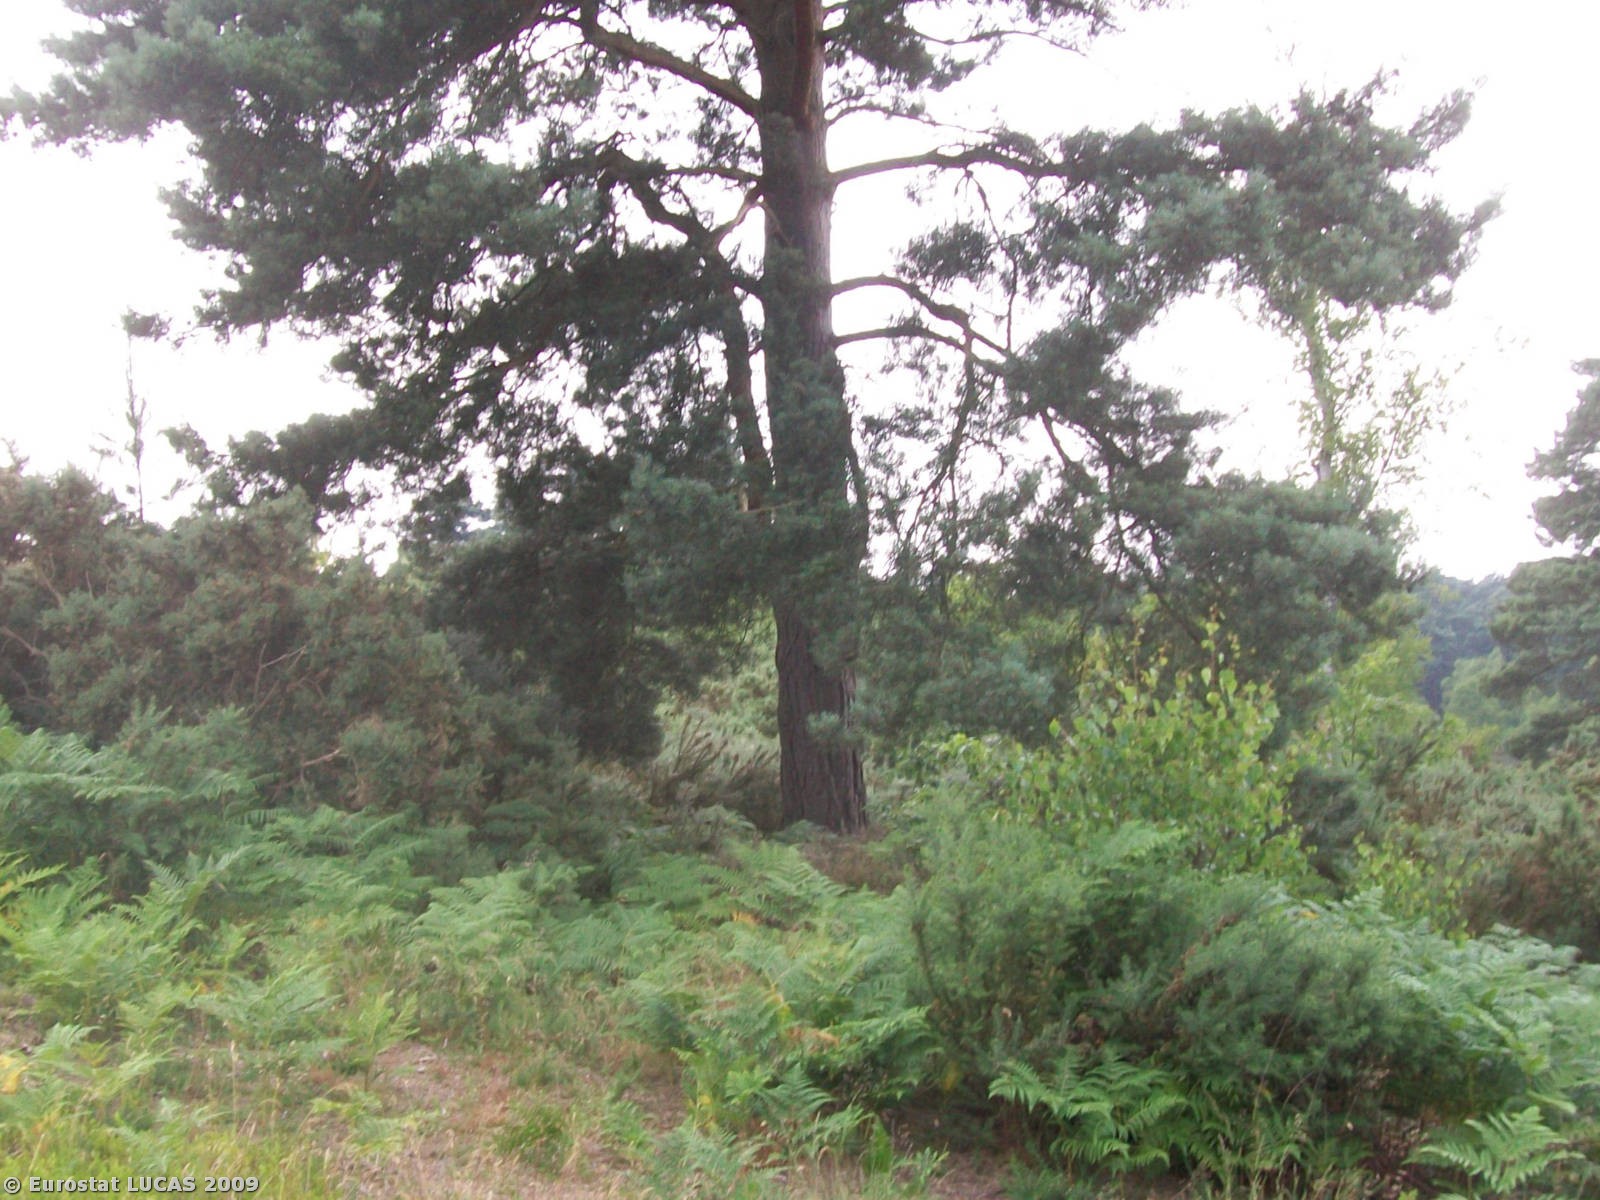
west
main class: Shrubland
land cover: Shrubland with sparse tree cover
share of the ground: > 75 %
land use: Amenities, museums, leisure
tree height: > 5 m
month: July
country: GB
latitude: 51.1521
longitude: -0.6627
